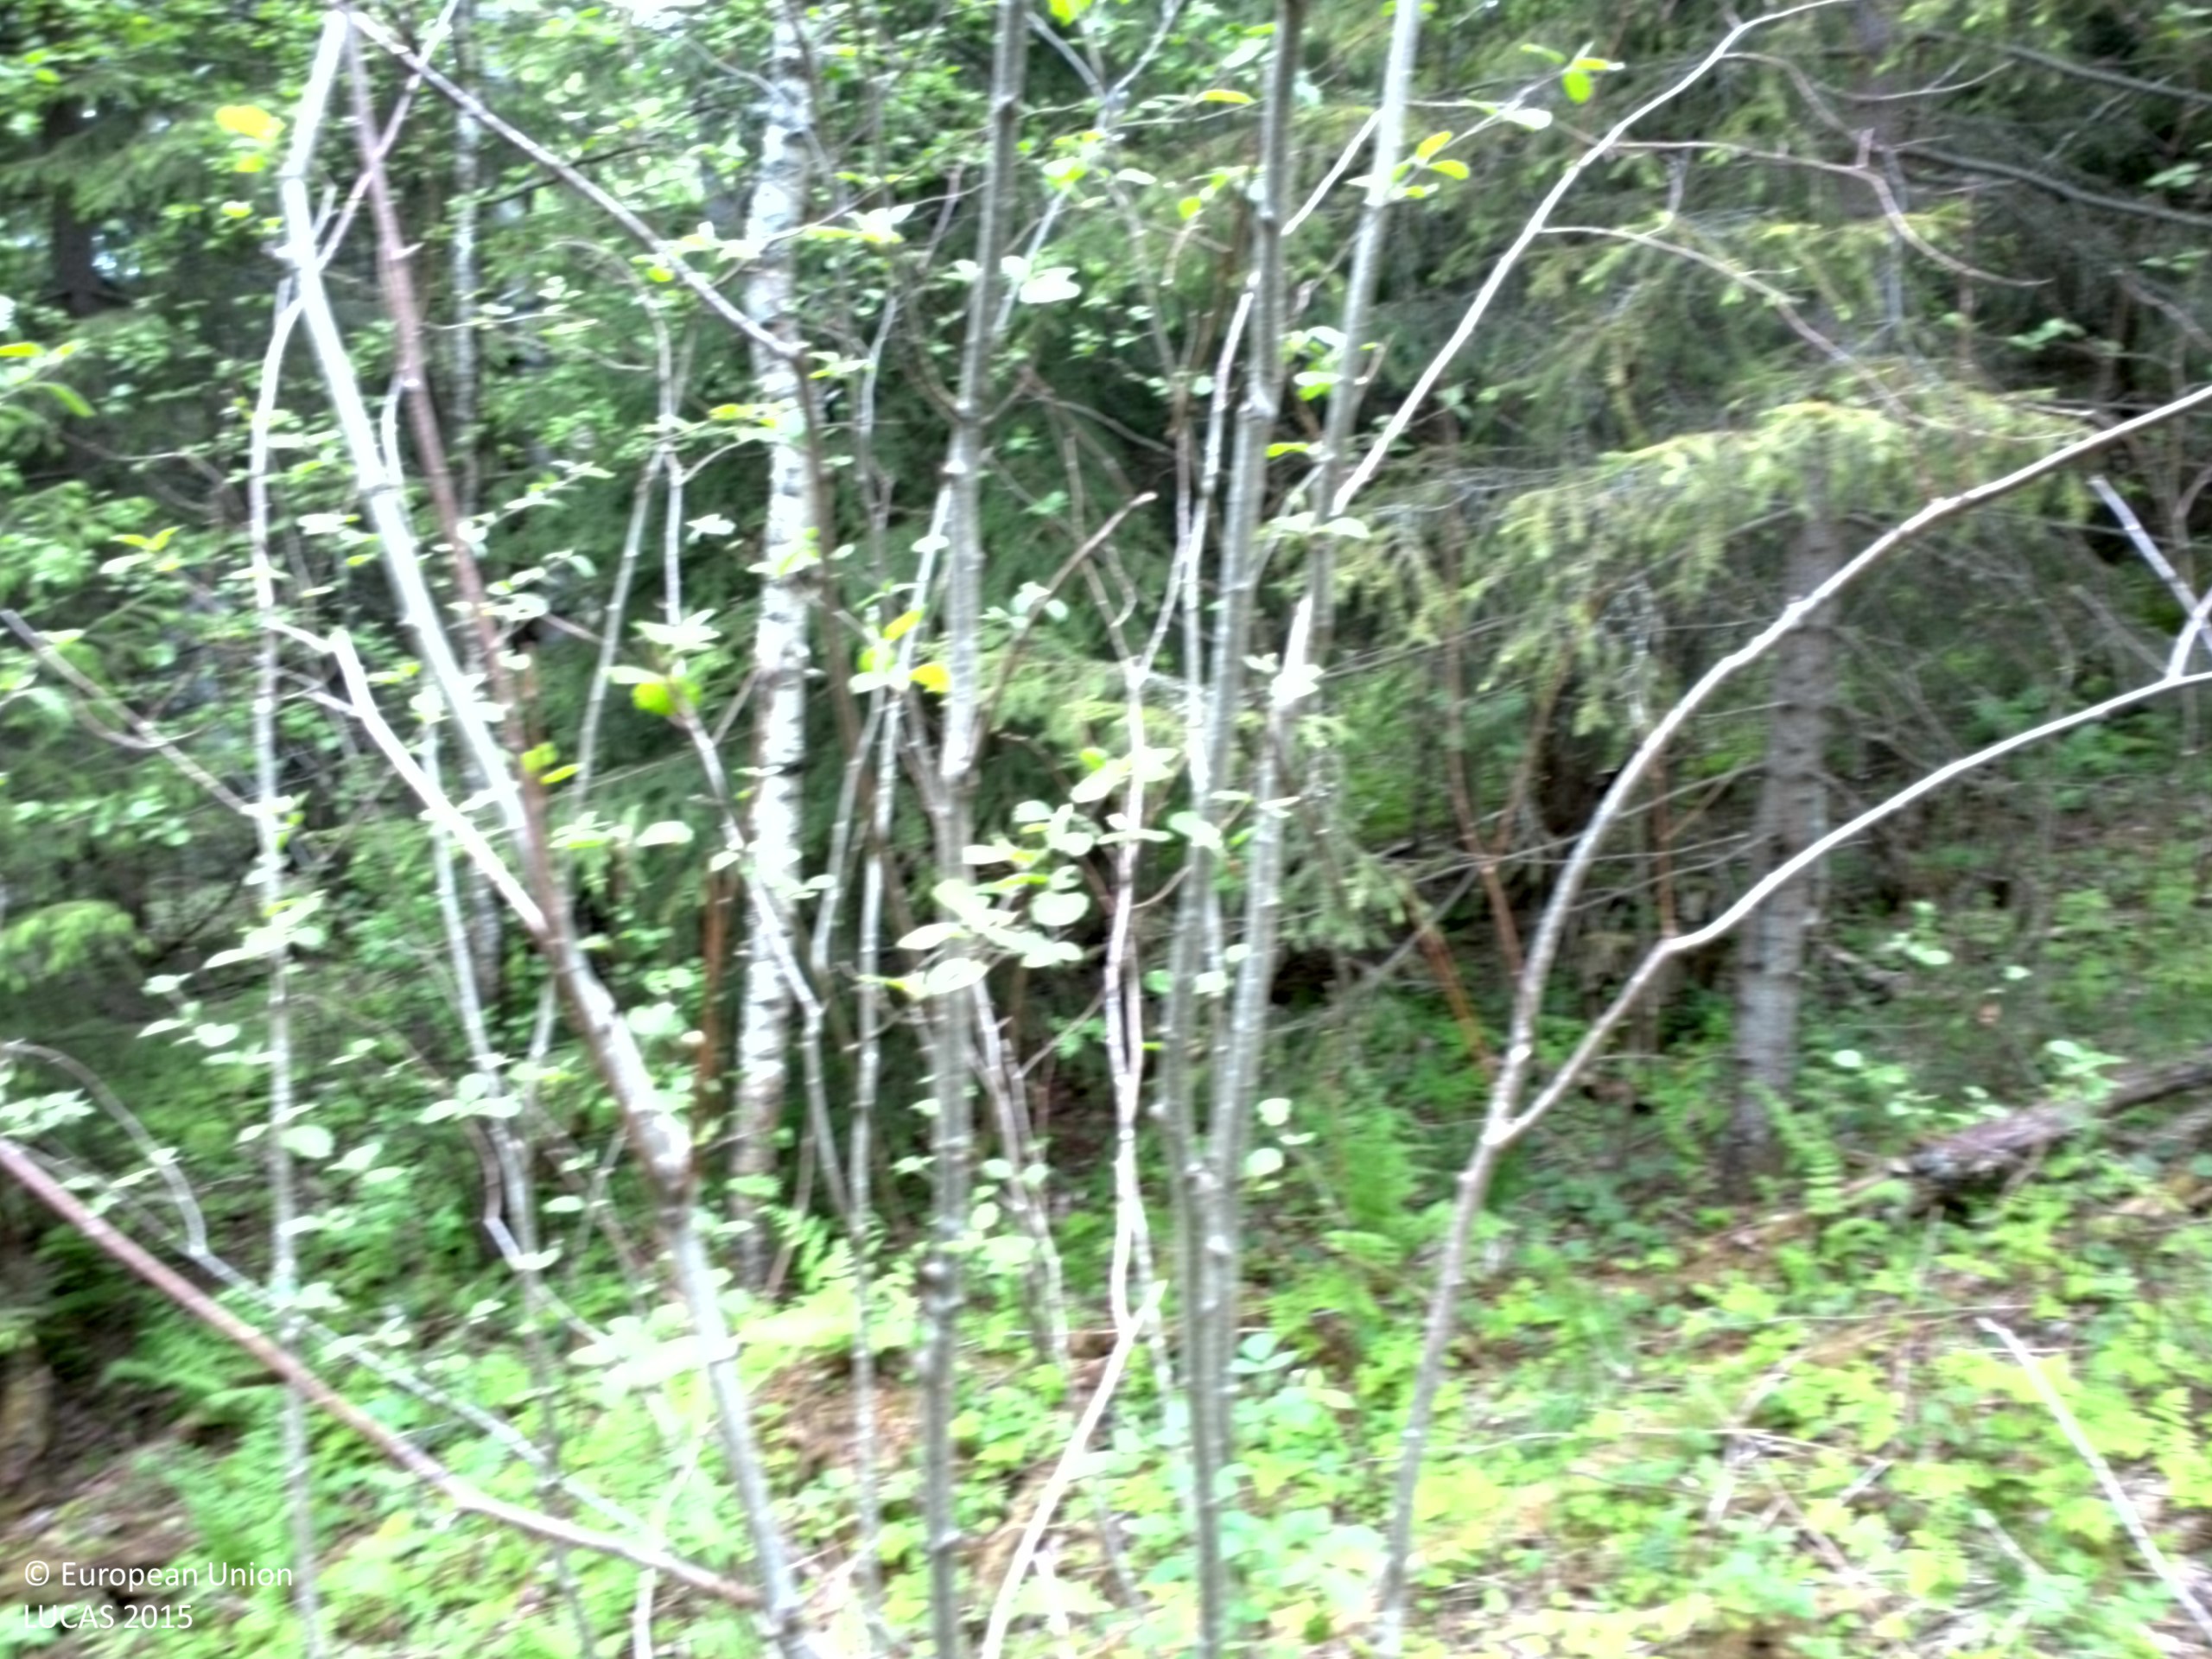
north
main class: Woodland
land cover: Other mixed woodland
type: boreal forest
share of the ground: > 75 %
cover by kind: broadleaved forest trees 60 %, coniferous forest trees 30 %, herbaceous plants 10 %
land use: Forestry
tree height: > 5 m
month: June
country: SE
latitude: 63.1030
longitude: 17.7239
